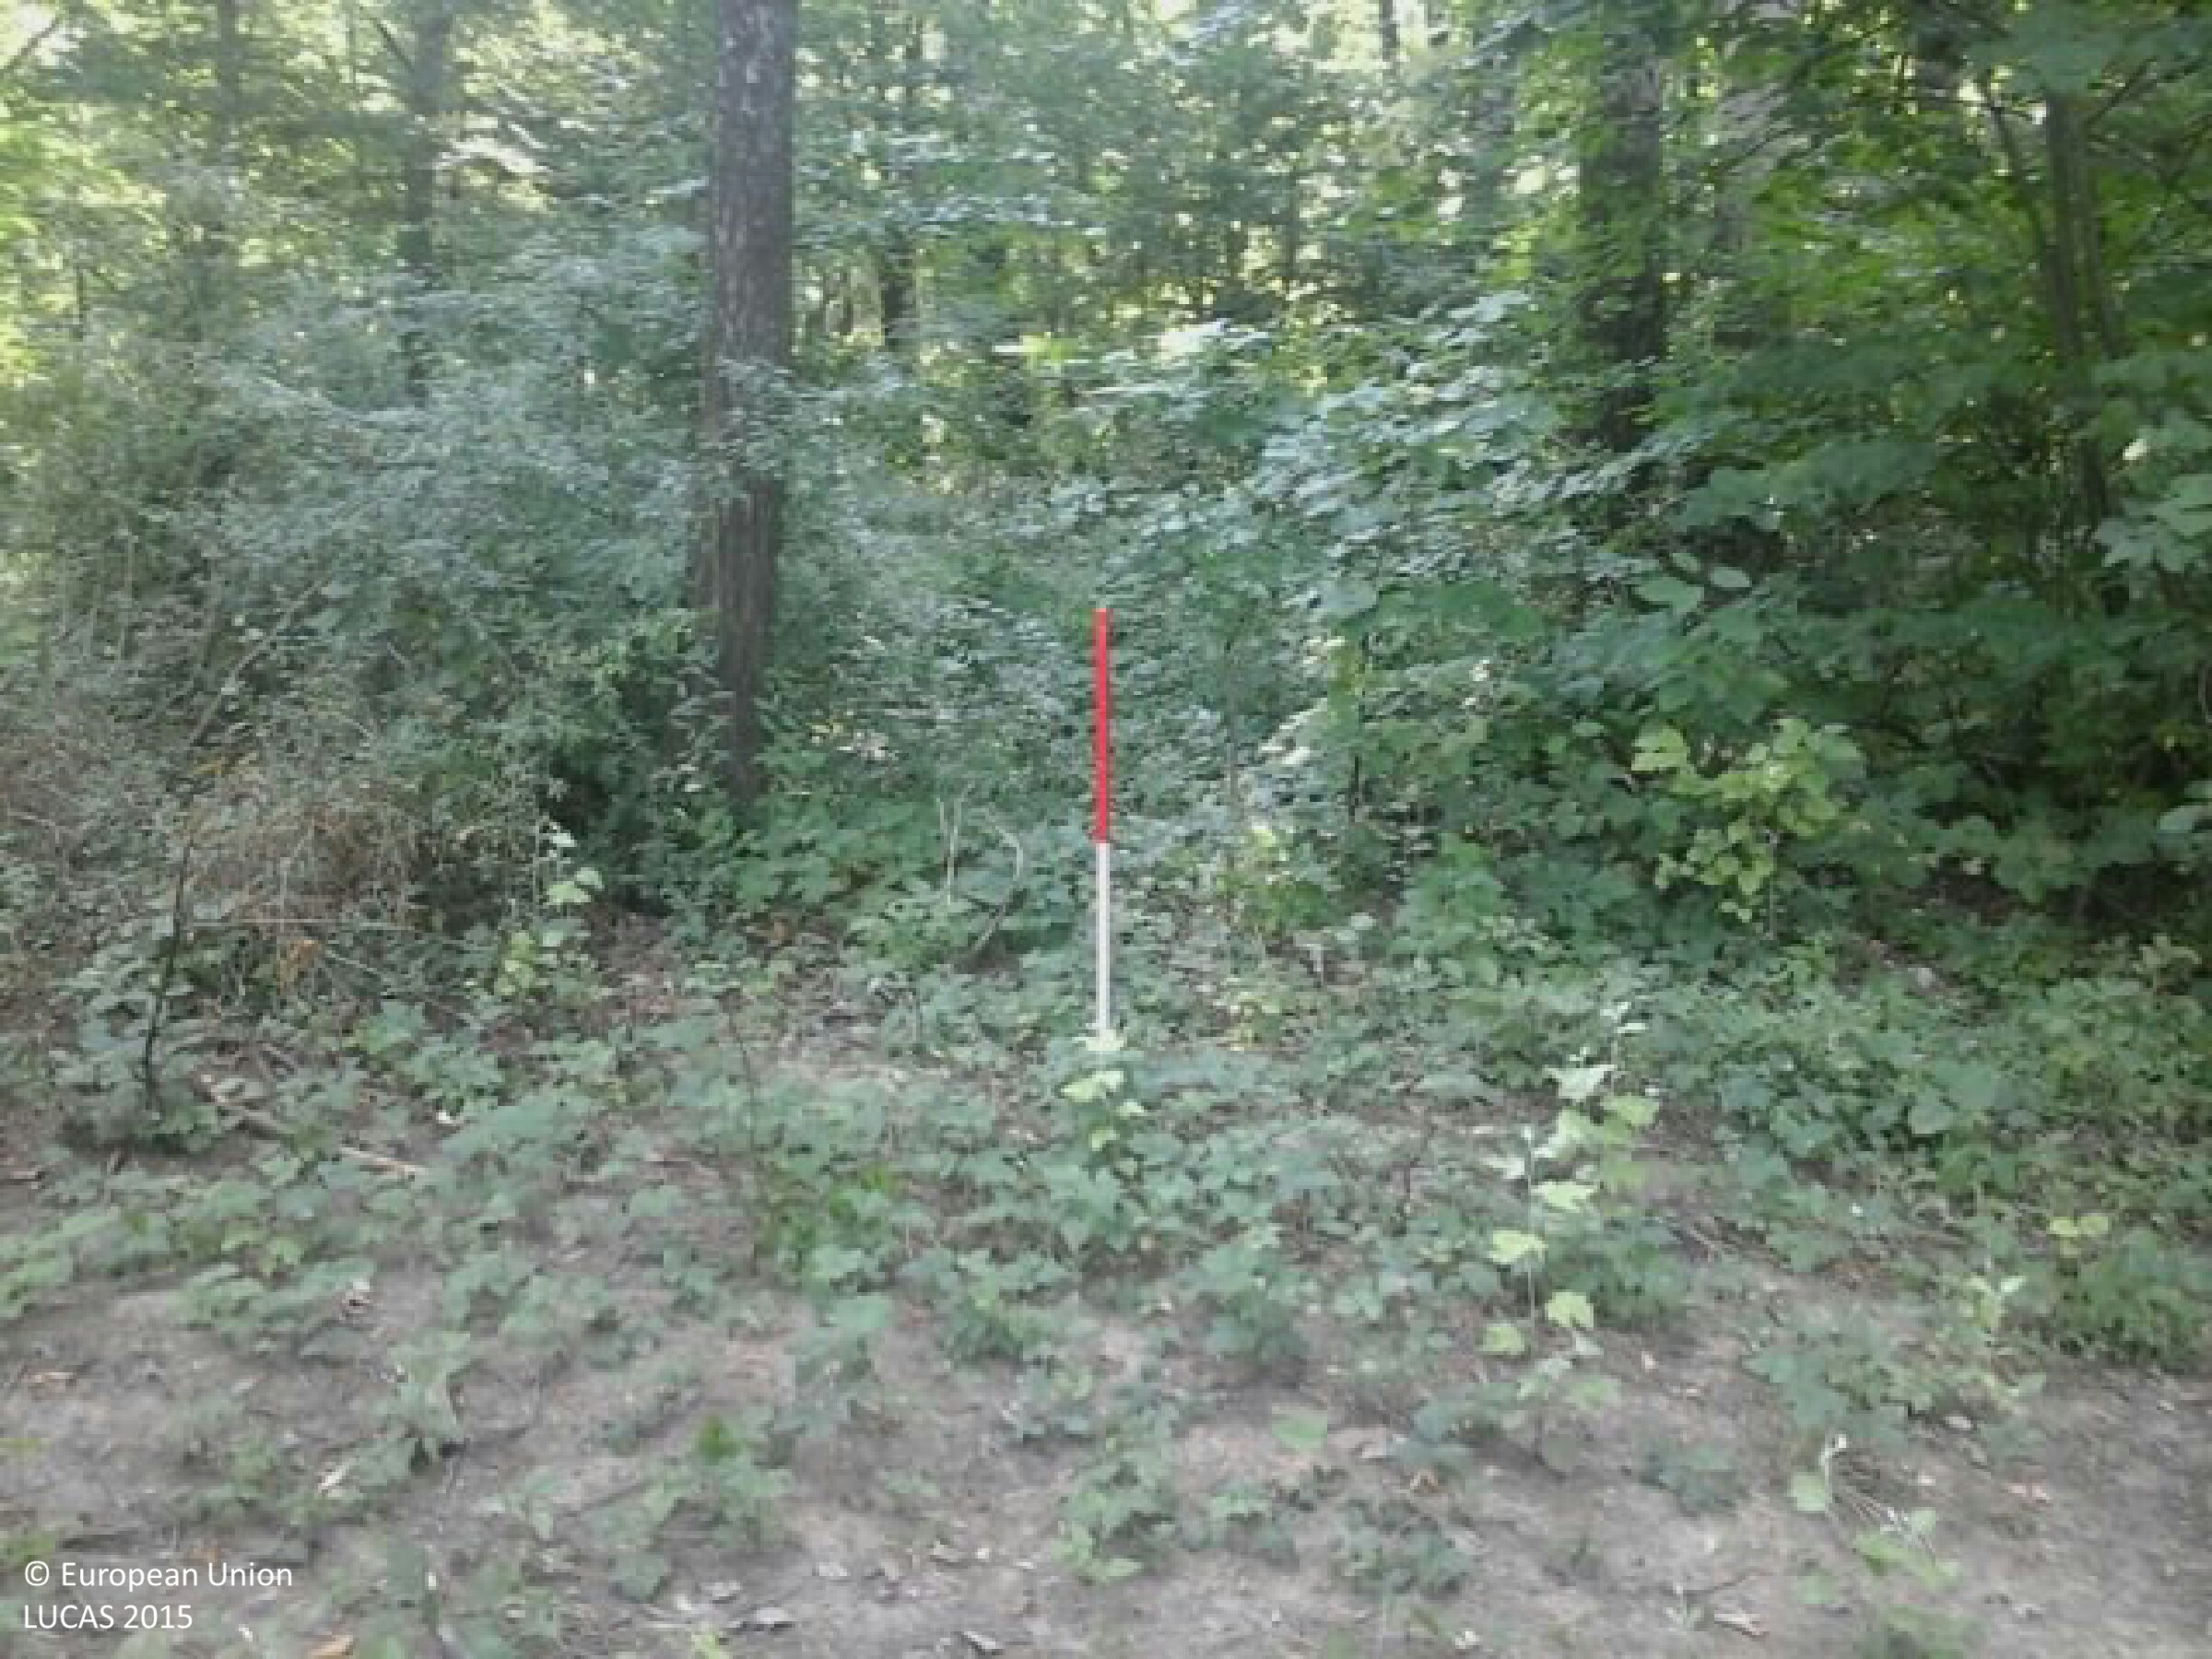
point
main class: Woodland
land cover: Broadleaved woodland
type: beech forest
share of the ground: > 75 %
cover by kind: broadleaved forest trees 95 %, herbaceous plants 5 %
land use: Forestry
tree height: < 5 m
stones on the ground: < 10 %
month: August
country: HU
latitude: 46.4106
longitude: 18.0338
